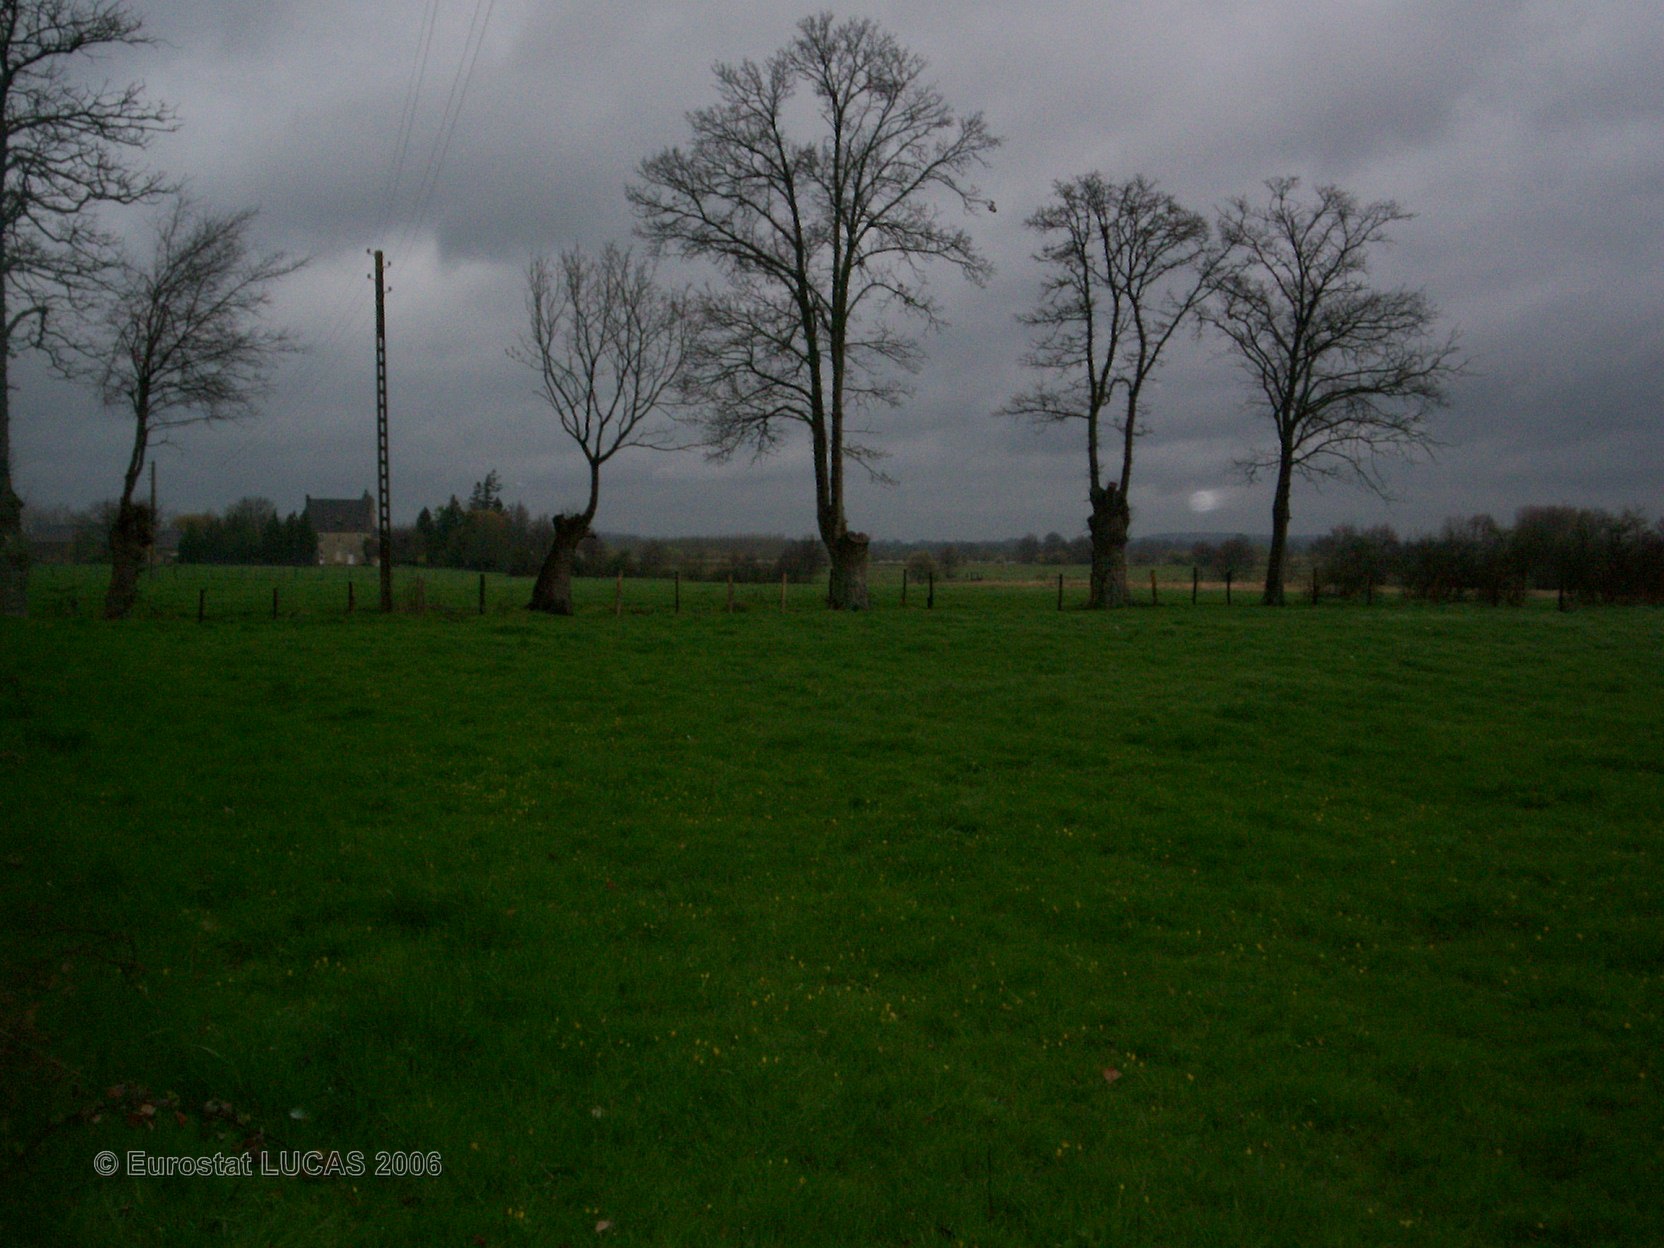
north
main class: Grassland
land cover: Grassland without tree/shrub cover
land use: Agriculture (excluding fallow land and kitchen gardens)
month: April
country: FR
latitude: 48.4656
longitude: 0.3034
